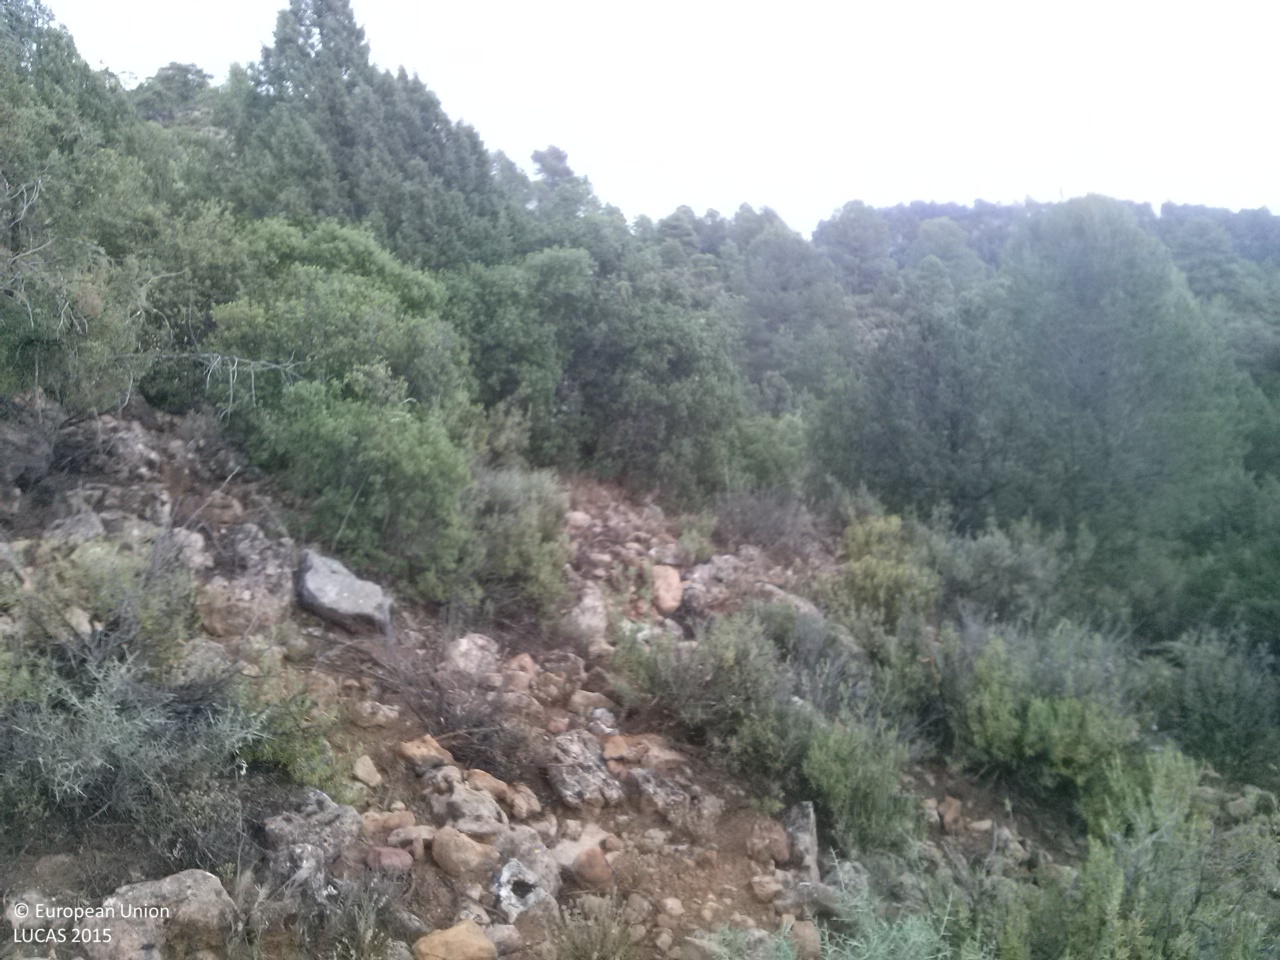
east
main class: Woodland
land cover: Other mixed woodland
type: broadleaved evergreen forest
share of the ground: 25 - 50 %
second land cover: Shrubland without tree cover
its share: 25 - 50 %
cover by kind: shrubs 35 %, broadleaved forest trees 25 %, unconsolidated bare surface 20 %, coniferous forest trees 10 %, herbaceous plants 10 %
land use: Forestry
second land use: Agriculture (excluding fallow land and kitchen gardens)
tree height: > 5 m
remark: Clear cut
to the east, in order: Other mixed woodland; Shrubland without tree cover; Other mixed woodland; Pine dominated mixed woodland; Pine dominated coniferous woodland; Ponds and wetlands; Pine dominated coniferous woodland
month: June
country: ES
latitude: 39.8267
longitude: -1.7990
